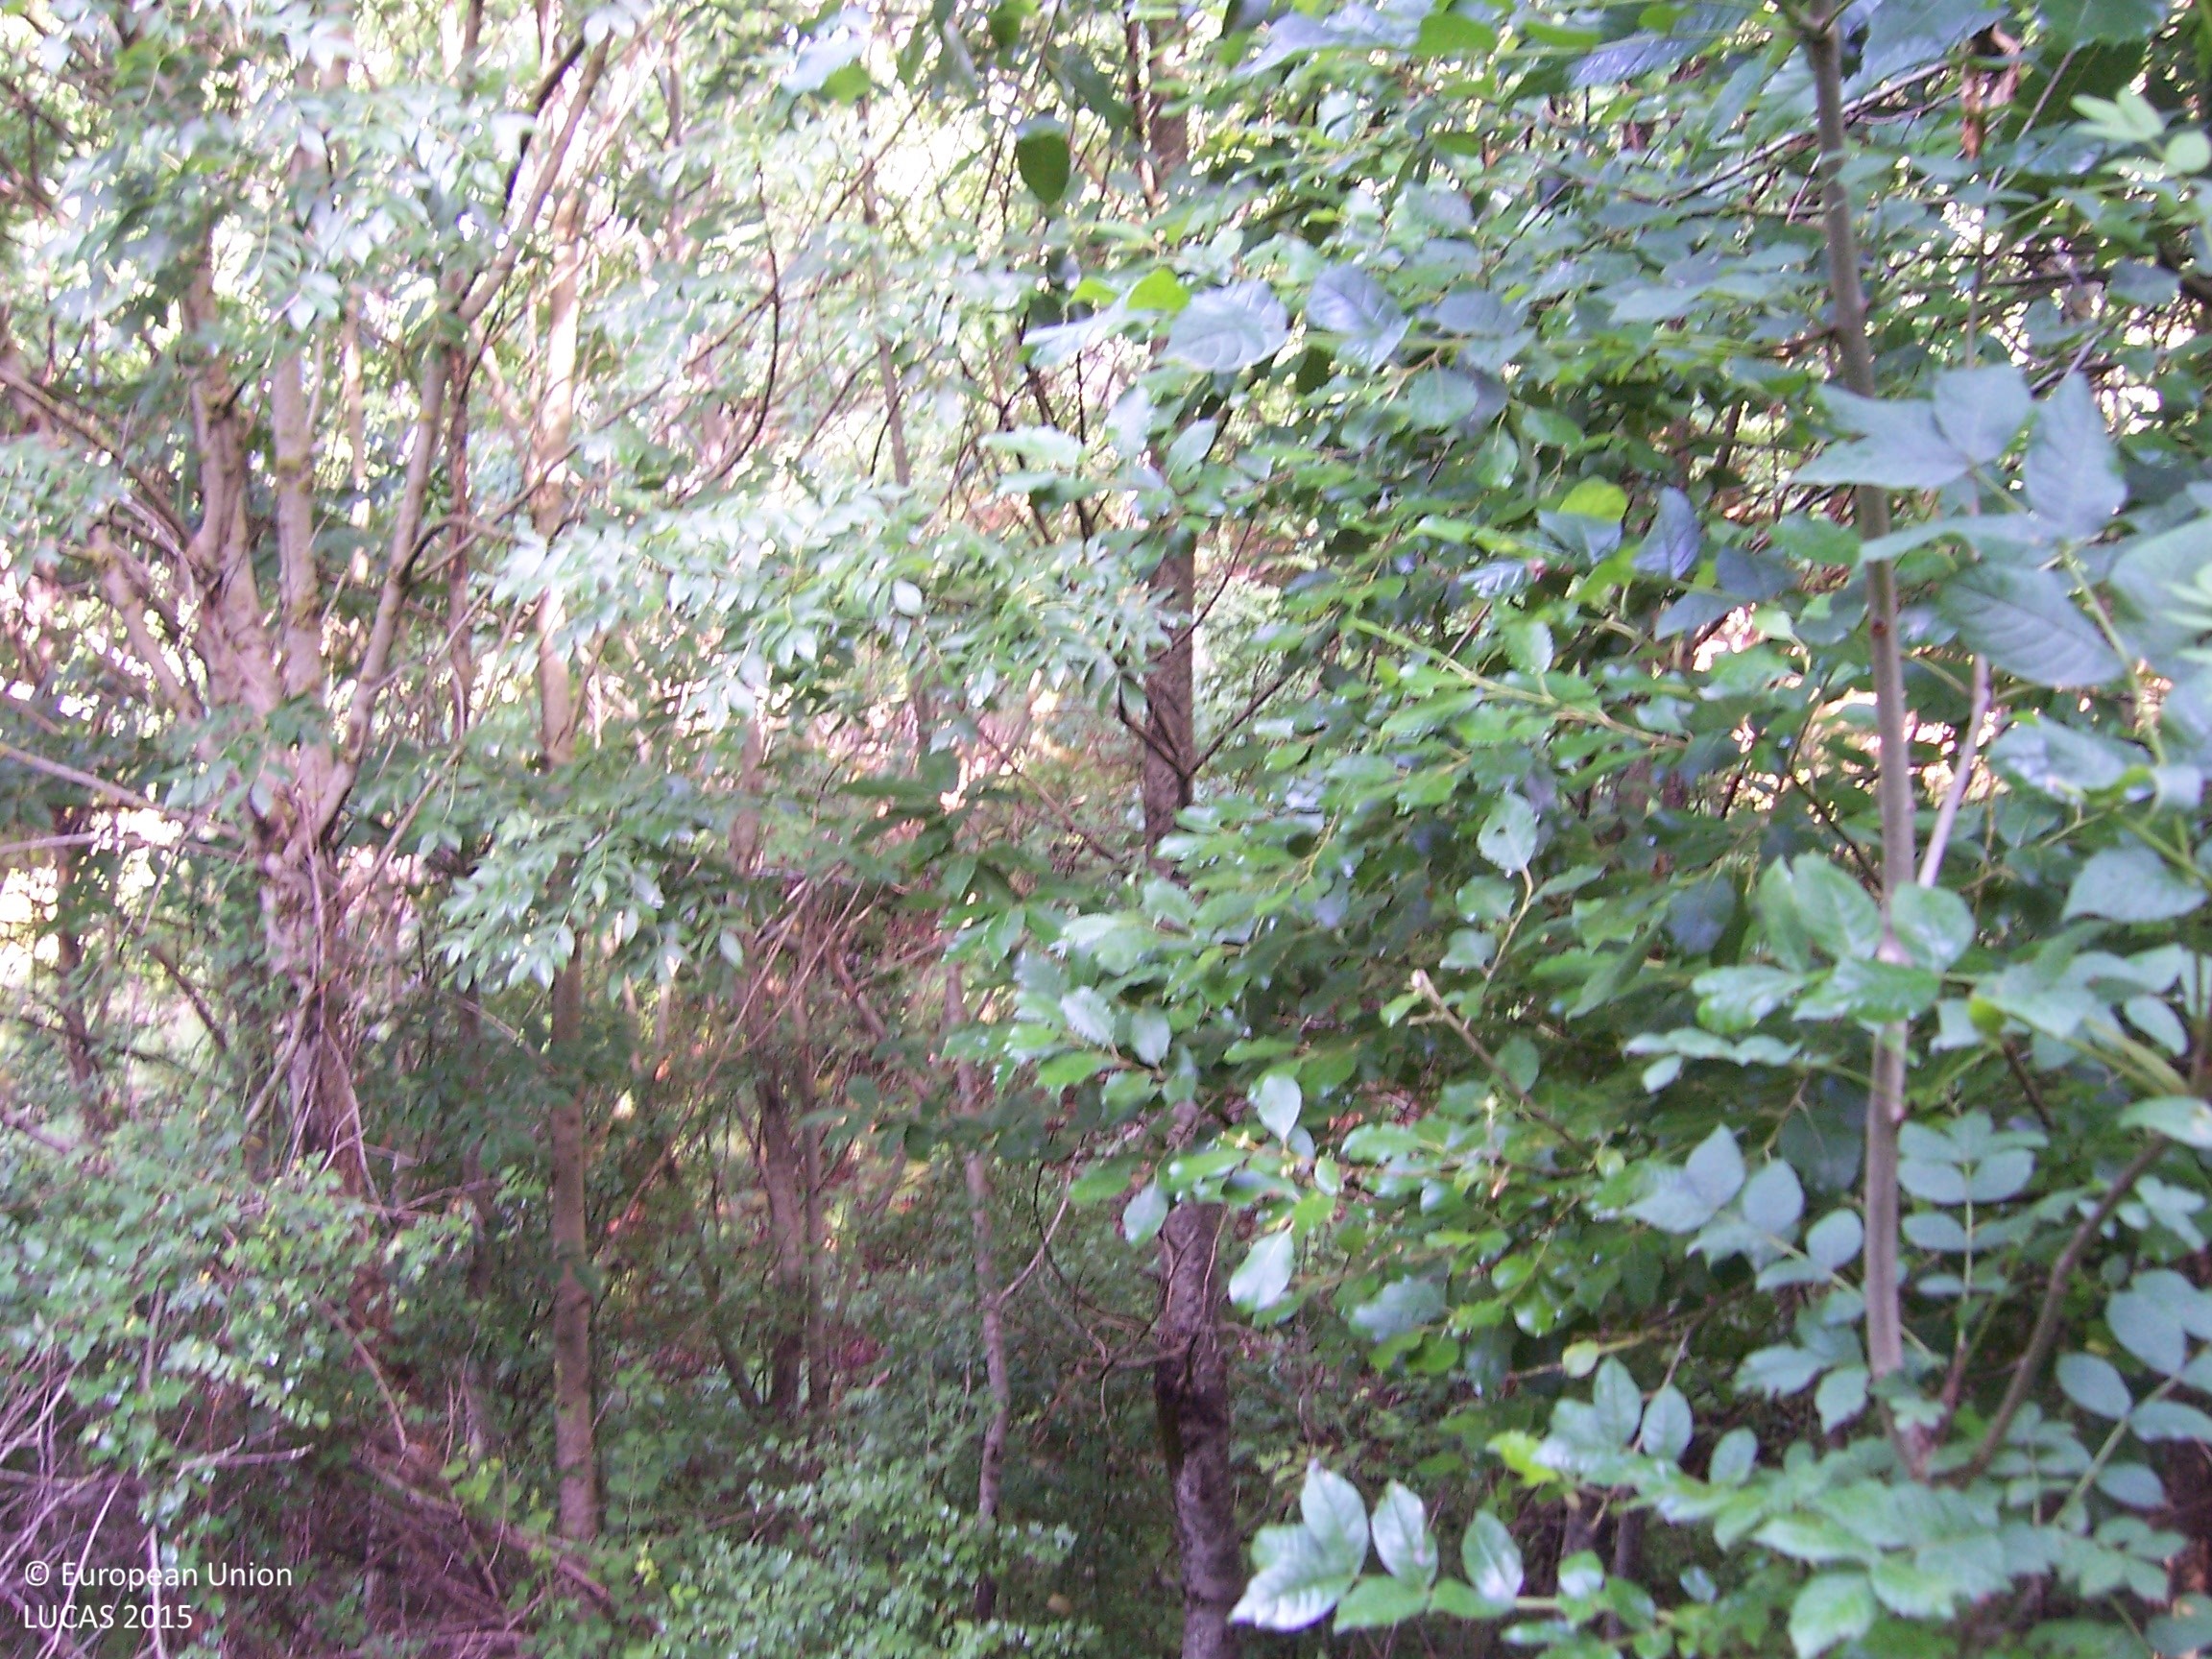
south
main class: Woodland
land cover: Broadleaved woodland
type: floodplain forest
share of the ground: > 75 %
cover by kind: broadleaved forest trees 100 %
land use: Semi-natural and natural areas not in use
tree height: > 5 m
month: July
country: ES
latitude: 42.9979
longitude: -1.5083
